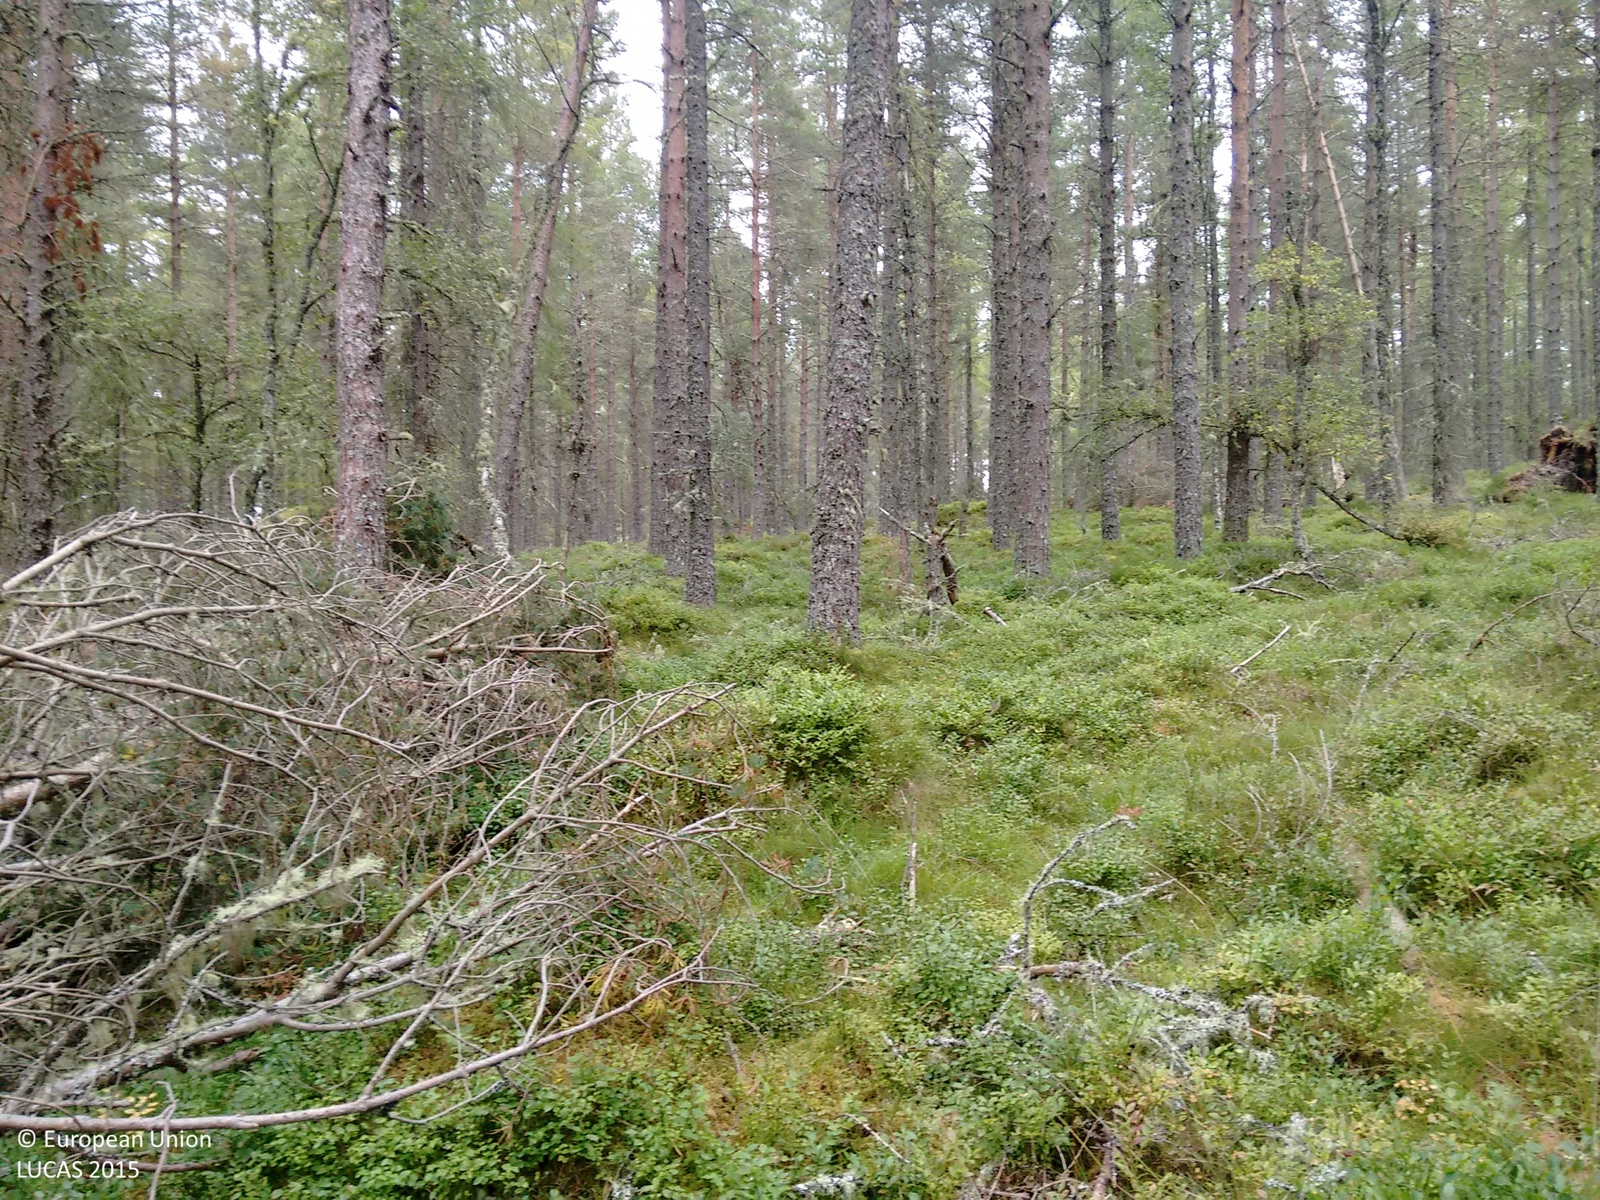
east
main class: Woodland
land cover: Pine dominated coniferous woodland
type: hemiboreal forest and nemoral coniferous forest and mixed broadleaved-coniferous forest
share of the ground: > 75 %
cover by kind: coniferous forest trees 80 %, shrubs 15 %, herbaceous plants 5 %
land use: Forestry
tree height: > 5 m
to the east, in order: Pine dominated coniferous woodland; Abandoned hedges; Tracks; Broadleaved woodland; Fences; Grassland without tree/shrub cover
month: September
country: GB
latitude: 57.7407
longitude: -4.3135
